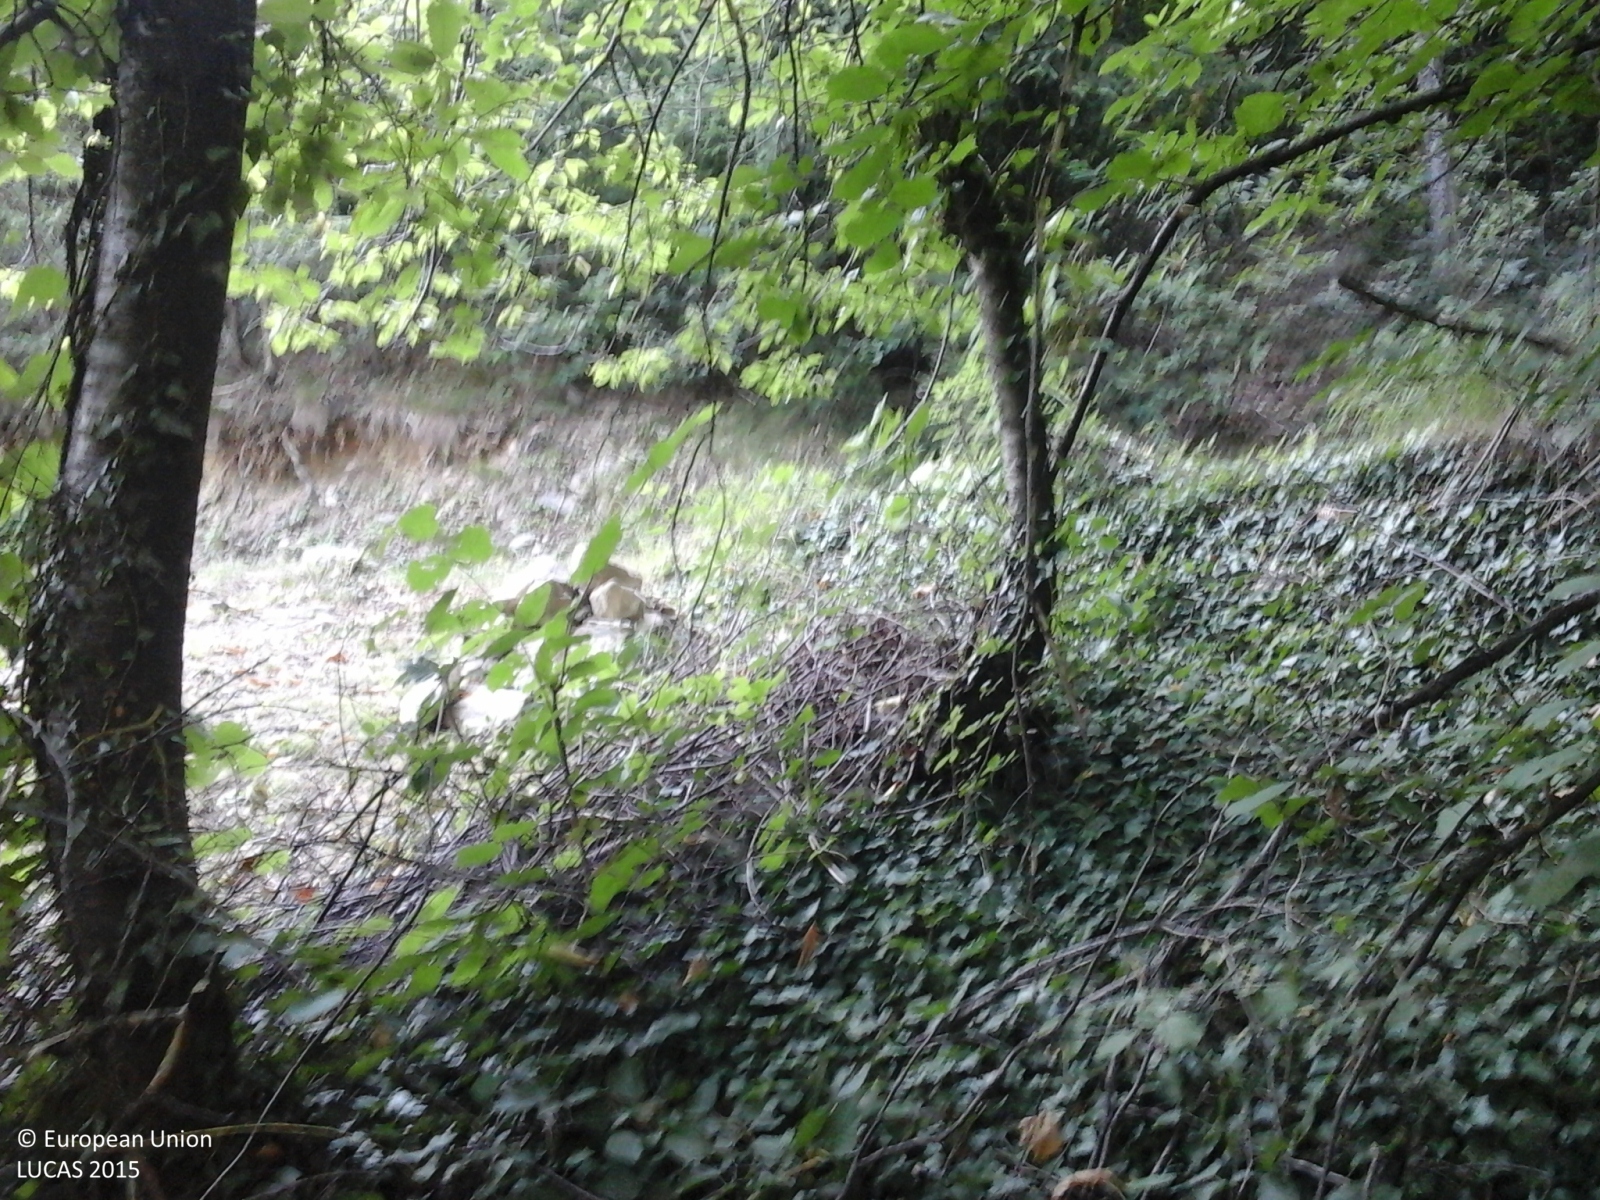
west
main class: Woodland
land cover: Broadleaved woodland
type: mountainous beech forest
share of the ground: > 75 %
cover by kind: broadleaved forest trees 100 %
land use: Semi-natural and natural areas not in use
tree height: > 5 m
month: July
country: IT
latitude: 46.2429
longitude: 10.2202
